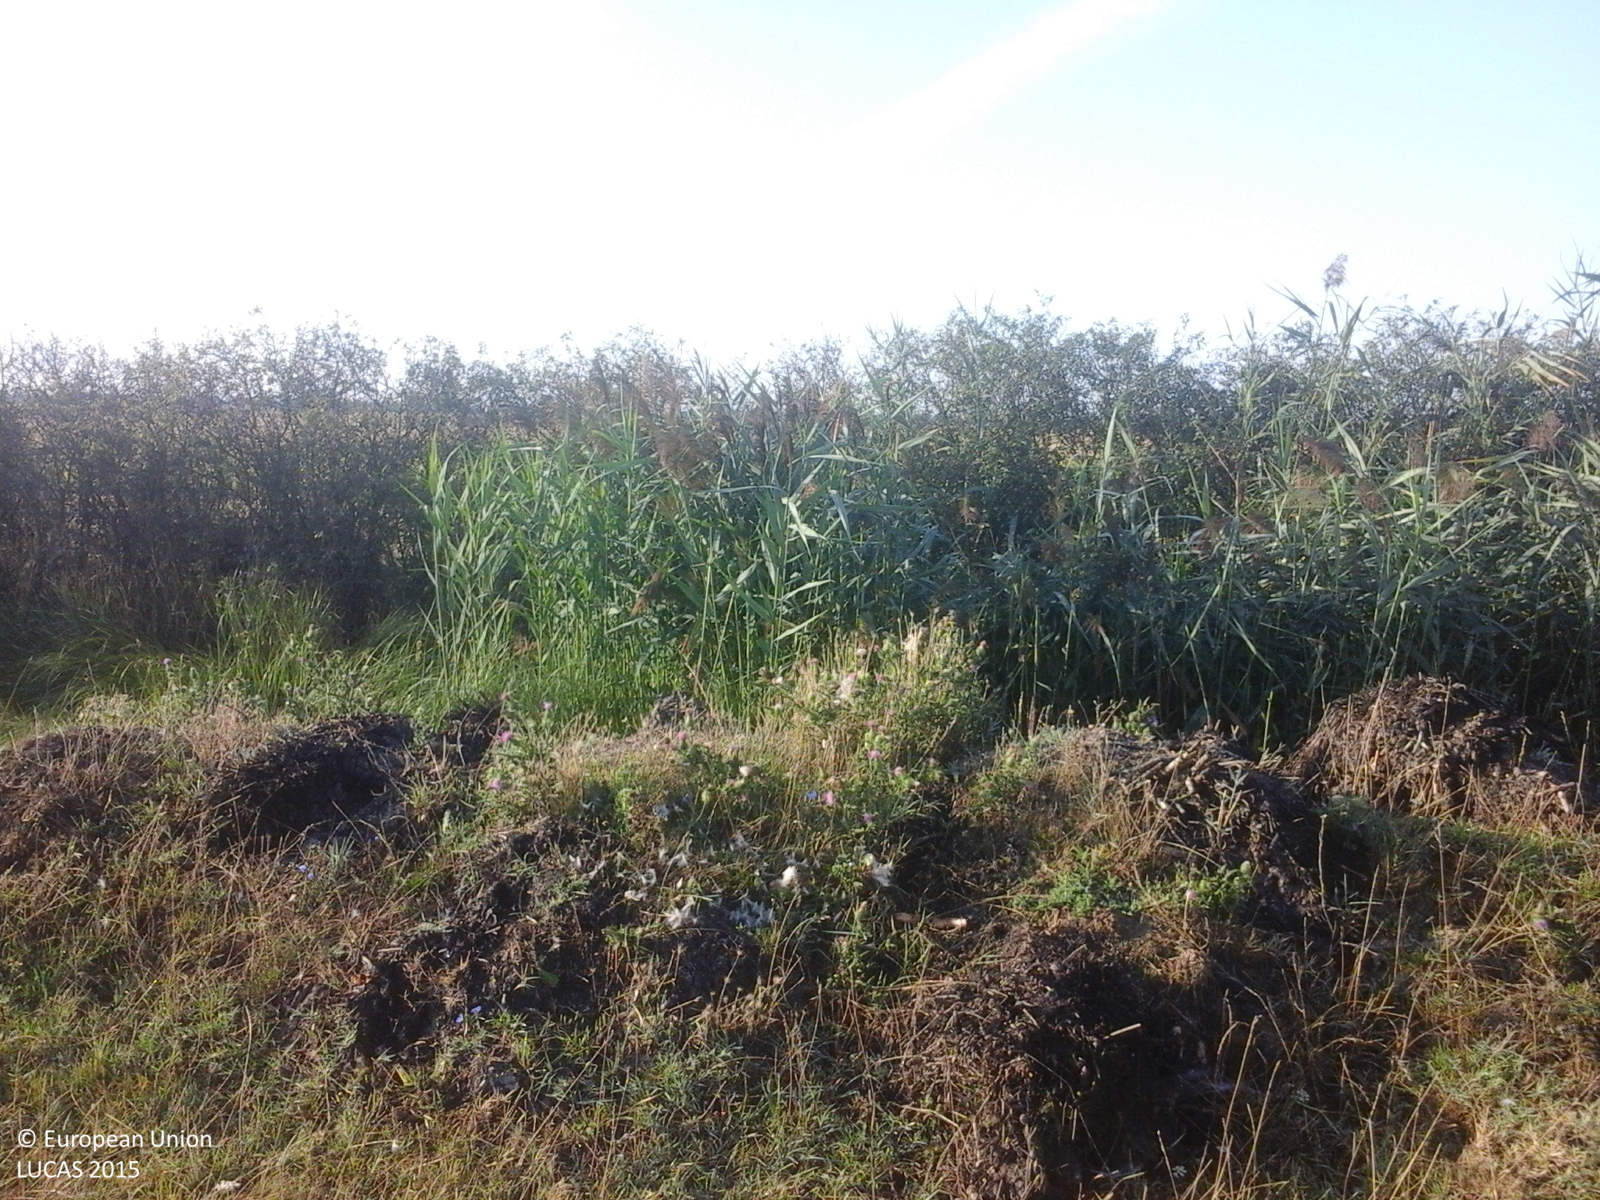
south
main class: Grassland
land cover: Grassland without tree/shrub cover
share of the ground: > 75 %
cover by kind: herbaceous plants 100 %
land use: Agriculture (excluding fallow land and kitchen gardens)
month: August
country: RO
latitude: 45.7056
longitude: 21.0359
